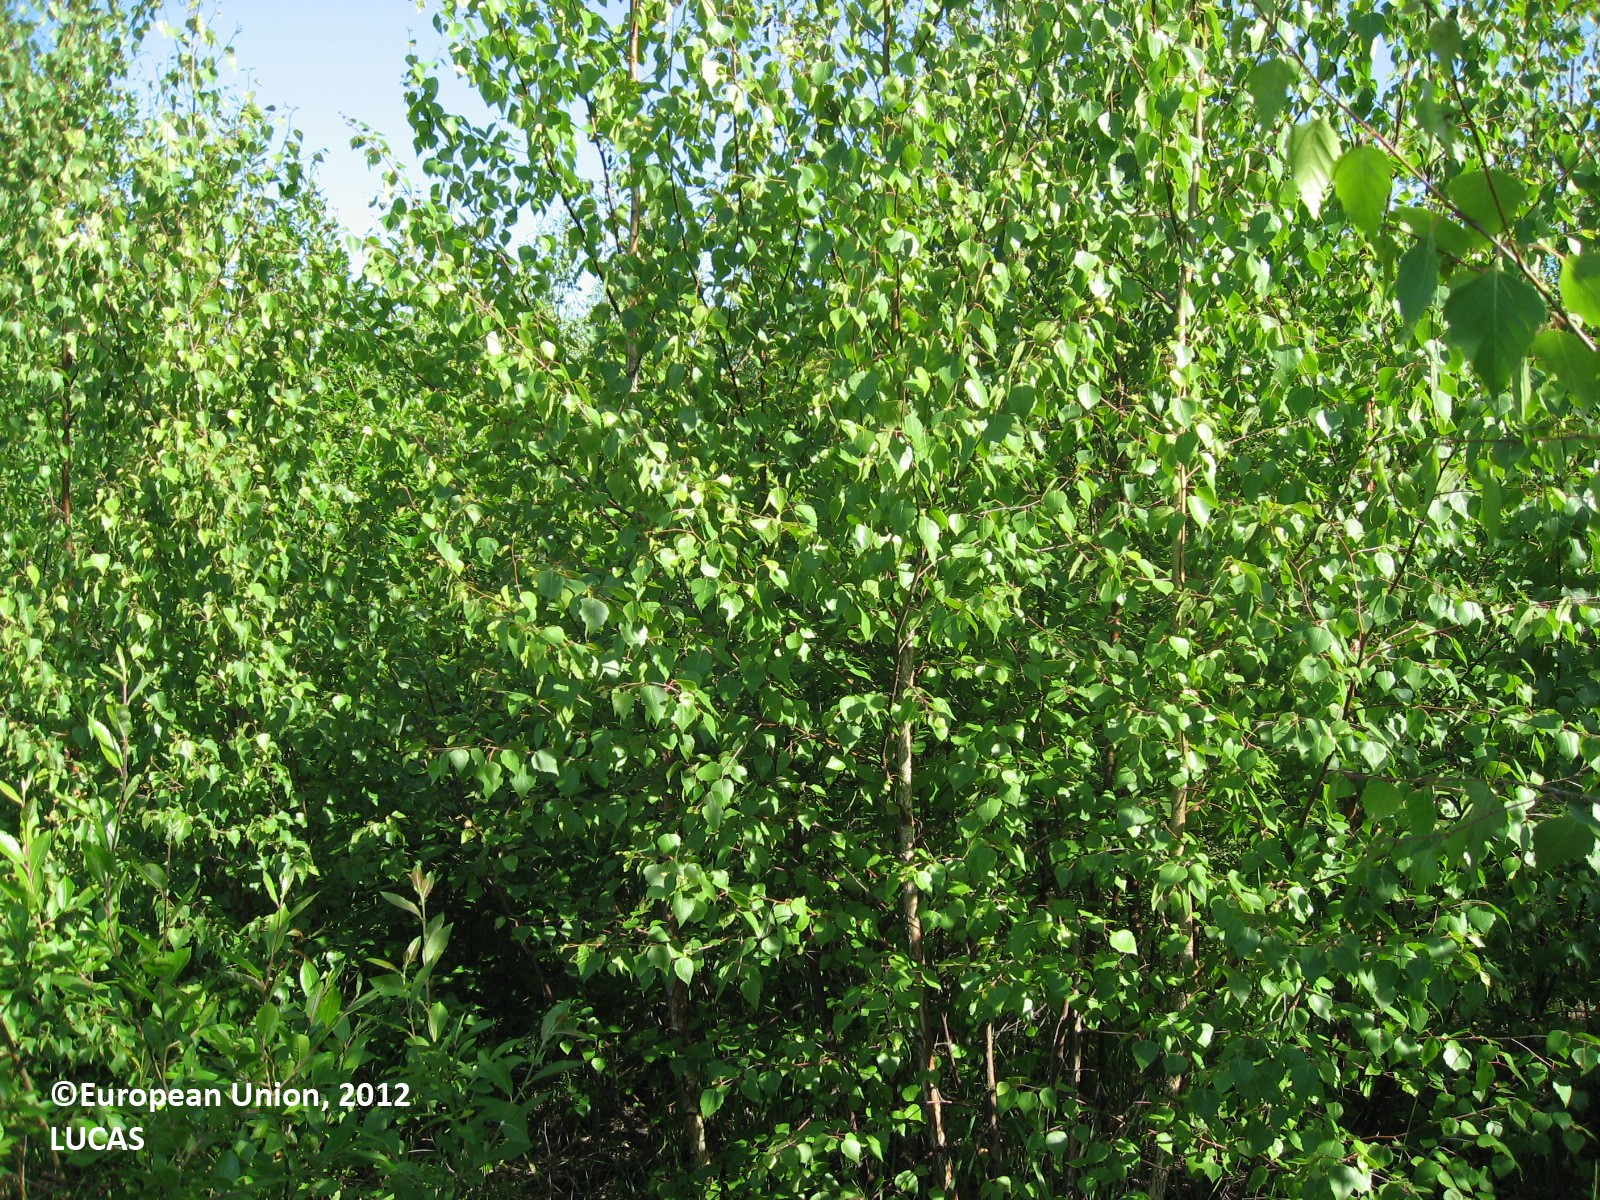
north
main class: Woodland
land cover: Broadleaved woodland
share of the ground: 50 - 75 %
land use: Water transport
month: June
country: FI
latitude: 60.4086
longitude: 26.2528
